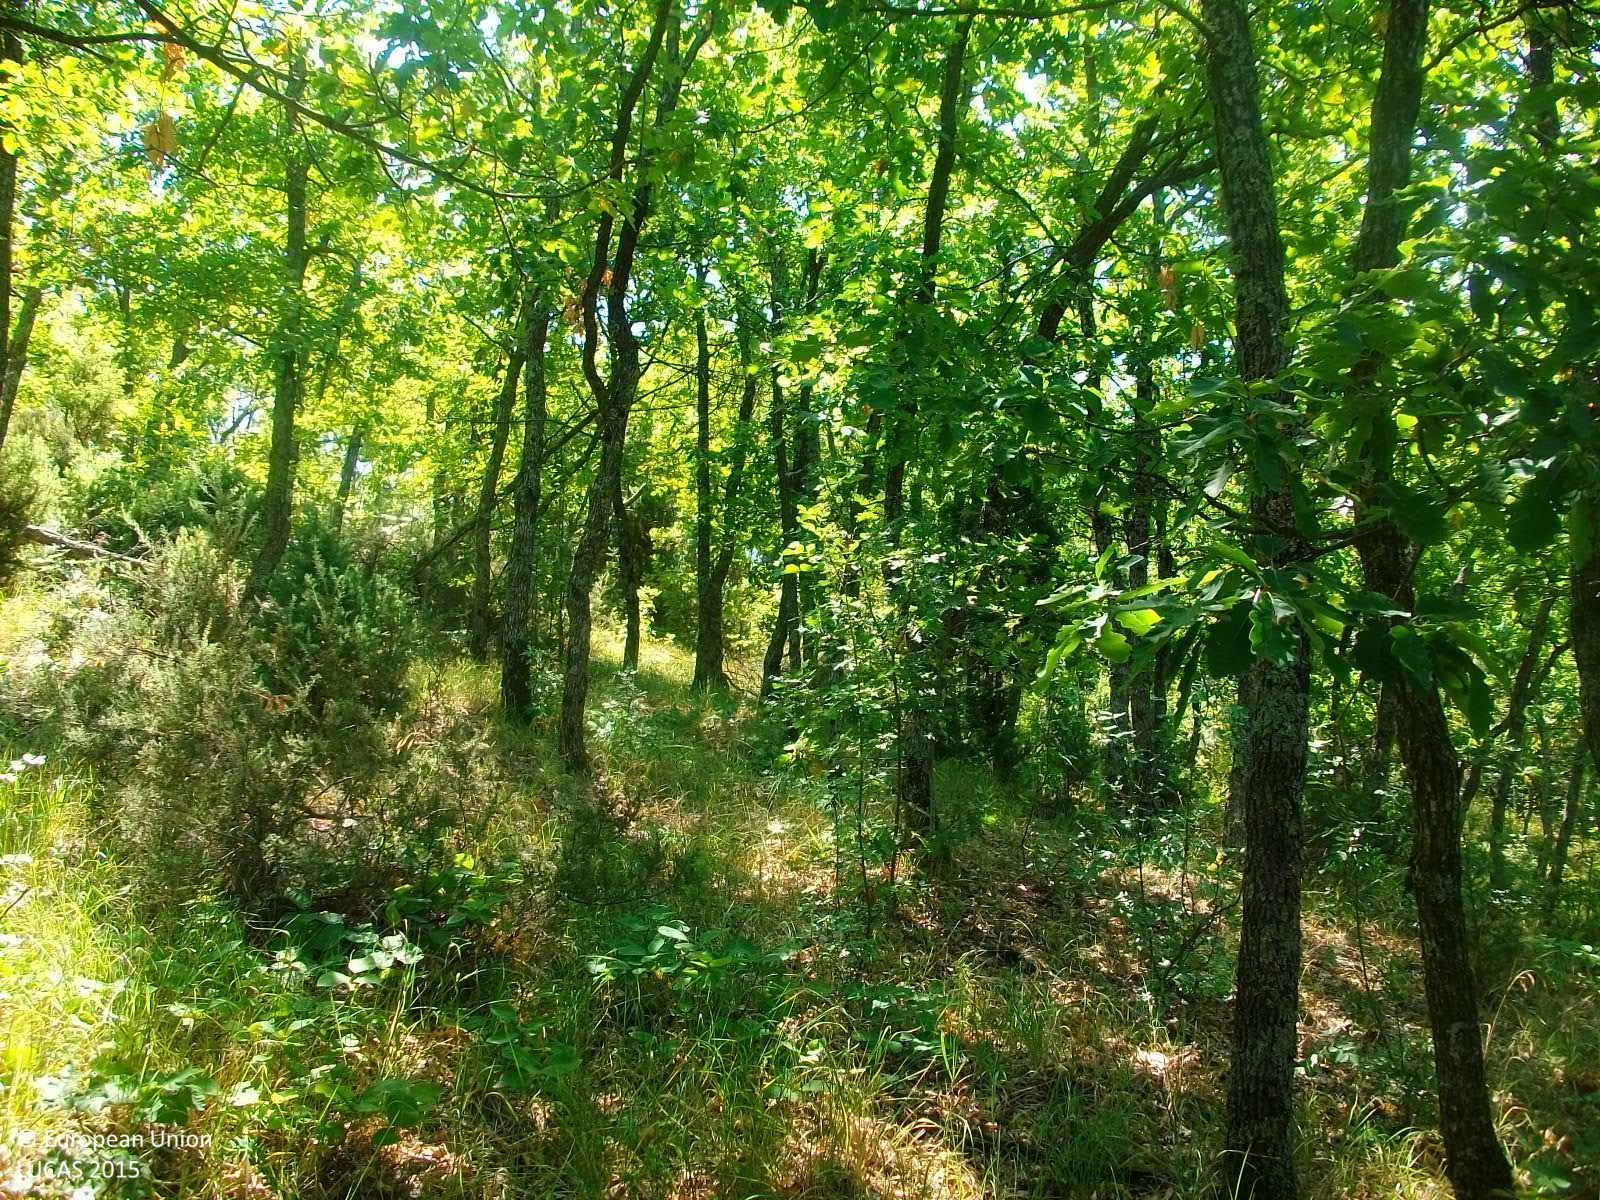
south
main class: Woodland
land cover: Broadleaved woodland
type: thermophilous deciduous forest
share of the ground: > 75 %
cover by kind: broadleaved forest trees 90 %, shrubs 5 %, herbaceous plants 5 %
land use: Forestry
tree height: > 5 m
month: August
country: GR
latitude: 41.2554
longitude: 26.2654
